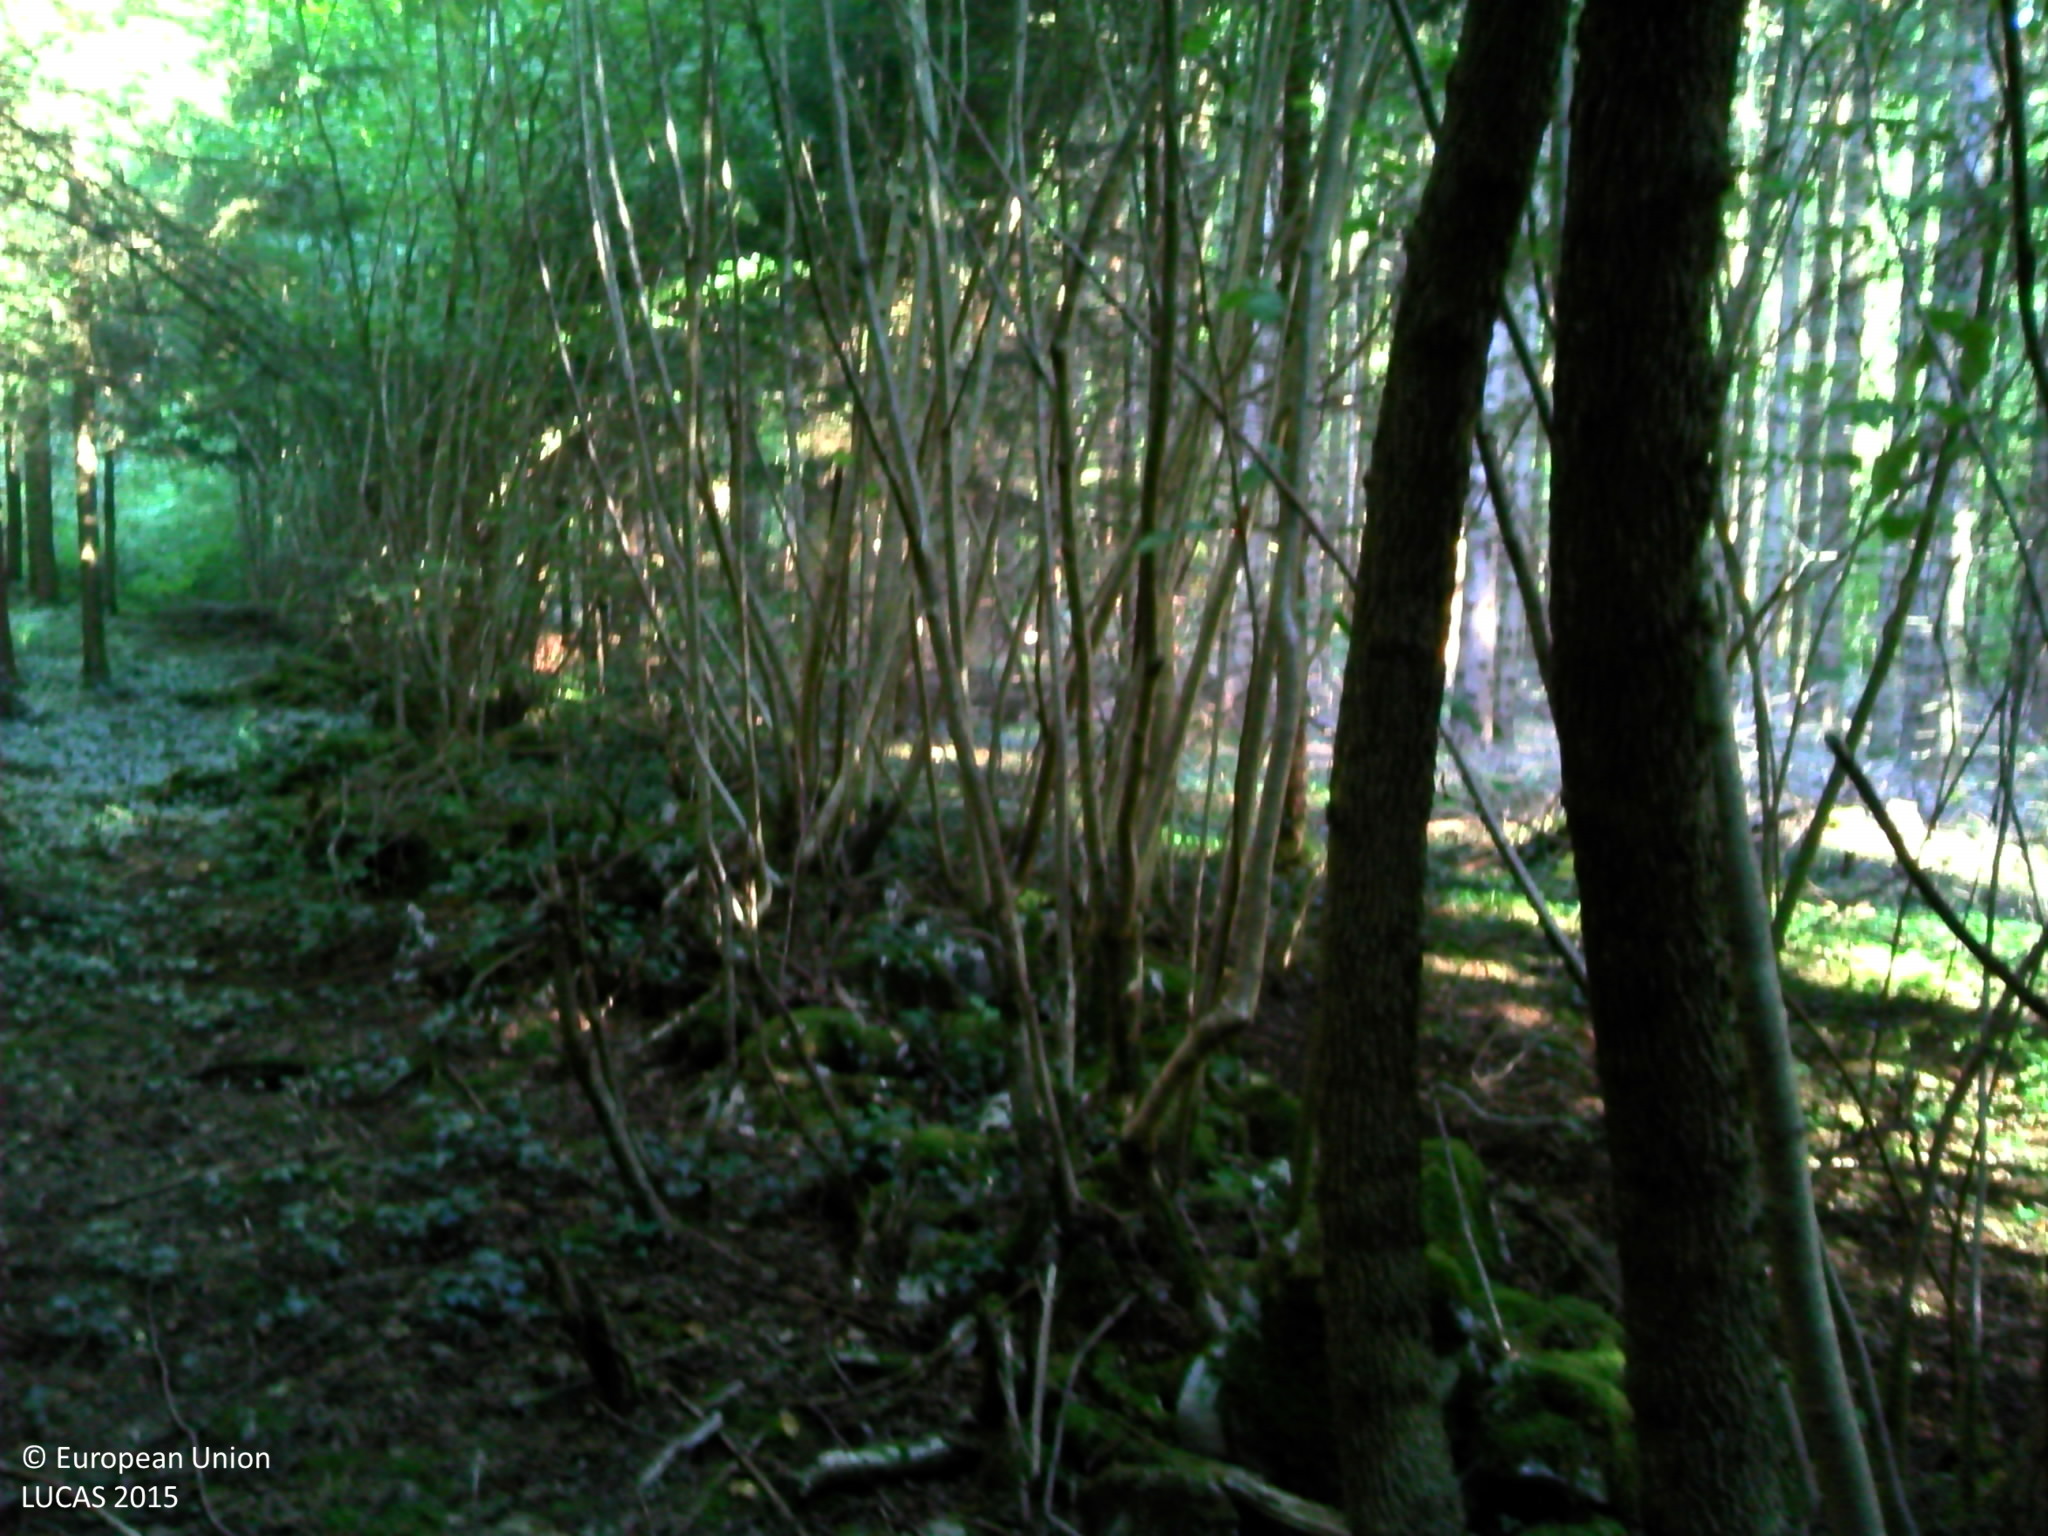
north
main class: Woodland
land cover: Spruce dominated coniferous woodland
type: alpine coniferous forest
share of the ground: > 75 %
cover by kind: coniferous forest trees 70 %, herbaceous plants 20 %, shrubs 10 %
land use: Forestry
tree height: > 5 m
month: September
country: FR
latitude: 47.2243
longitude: 6.2909
